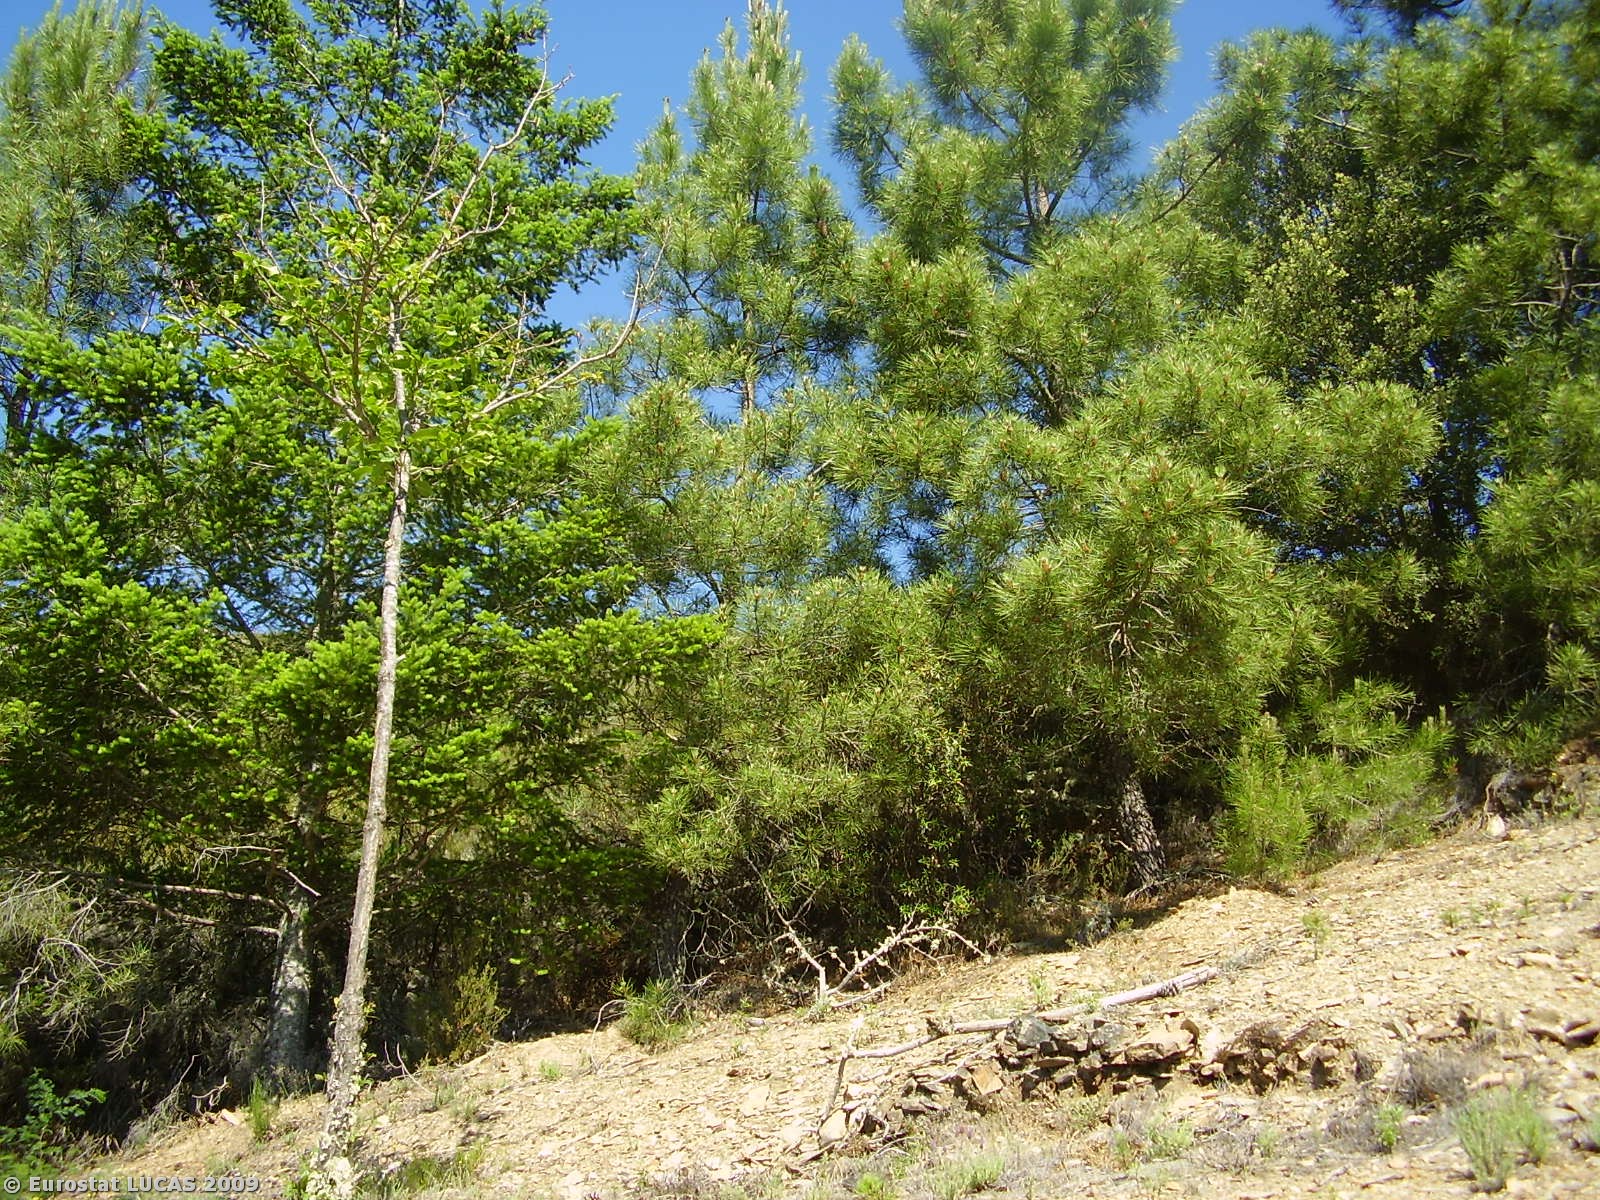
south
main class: Grassland
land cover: Spontaneously vegetated surfaces
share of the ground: > 75 %
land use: Nature reserves
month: June
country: PT
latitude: 41.9317
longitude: -6.6218
